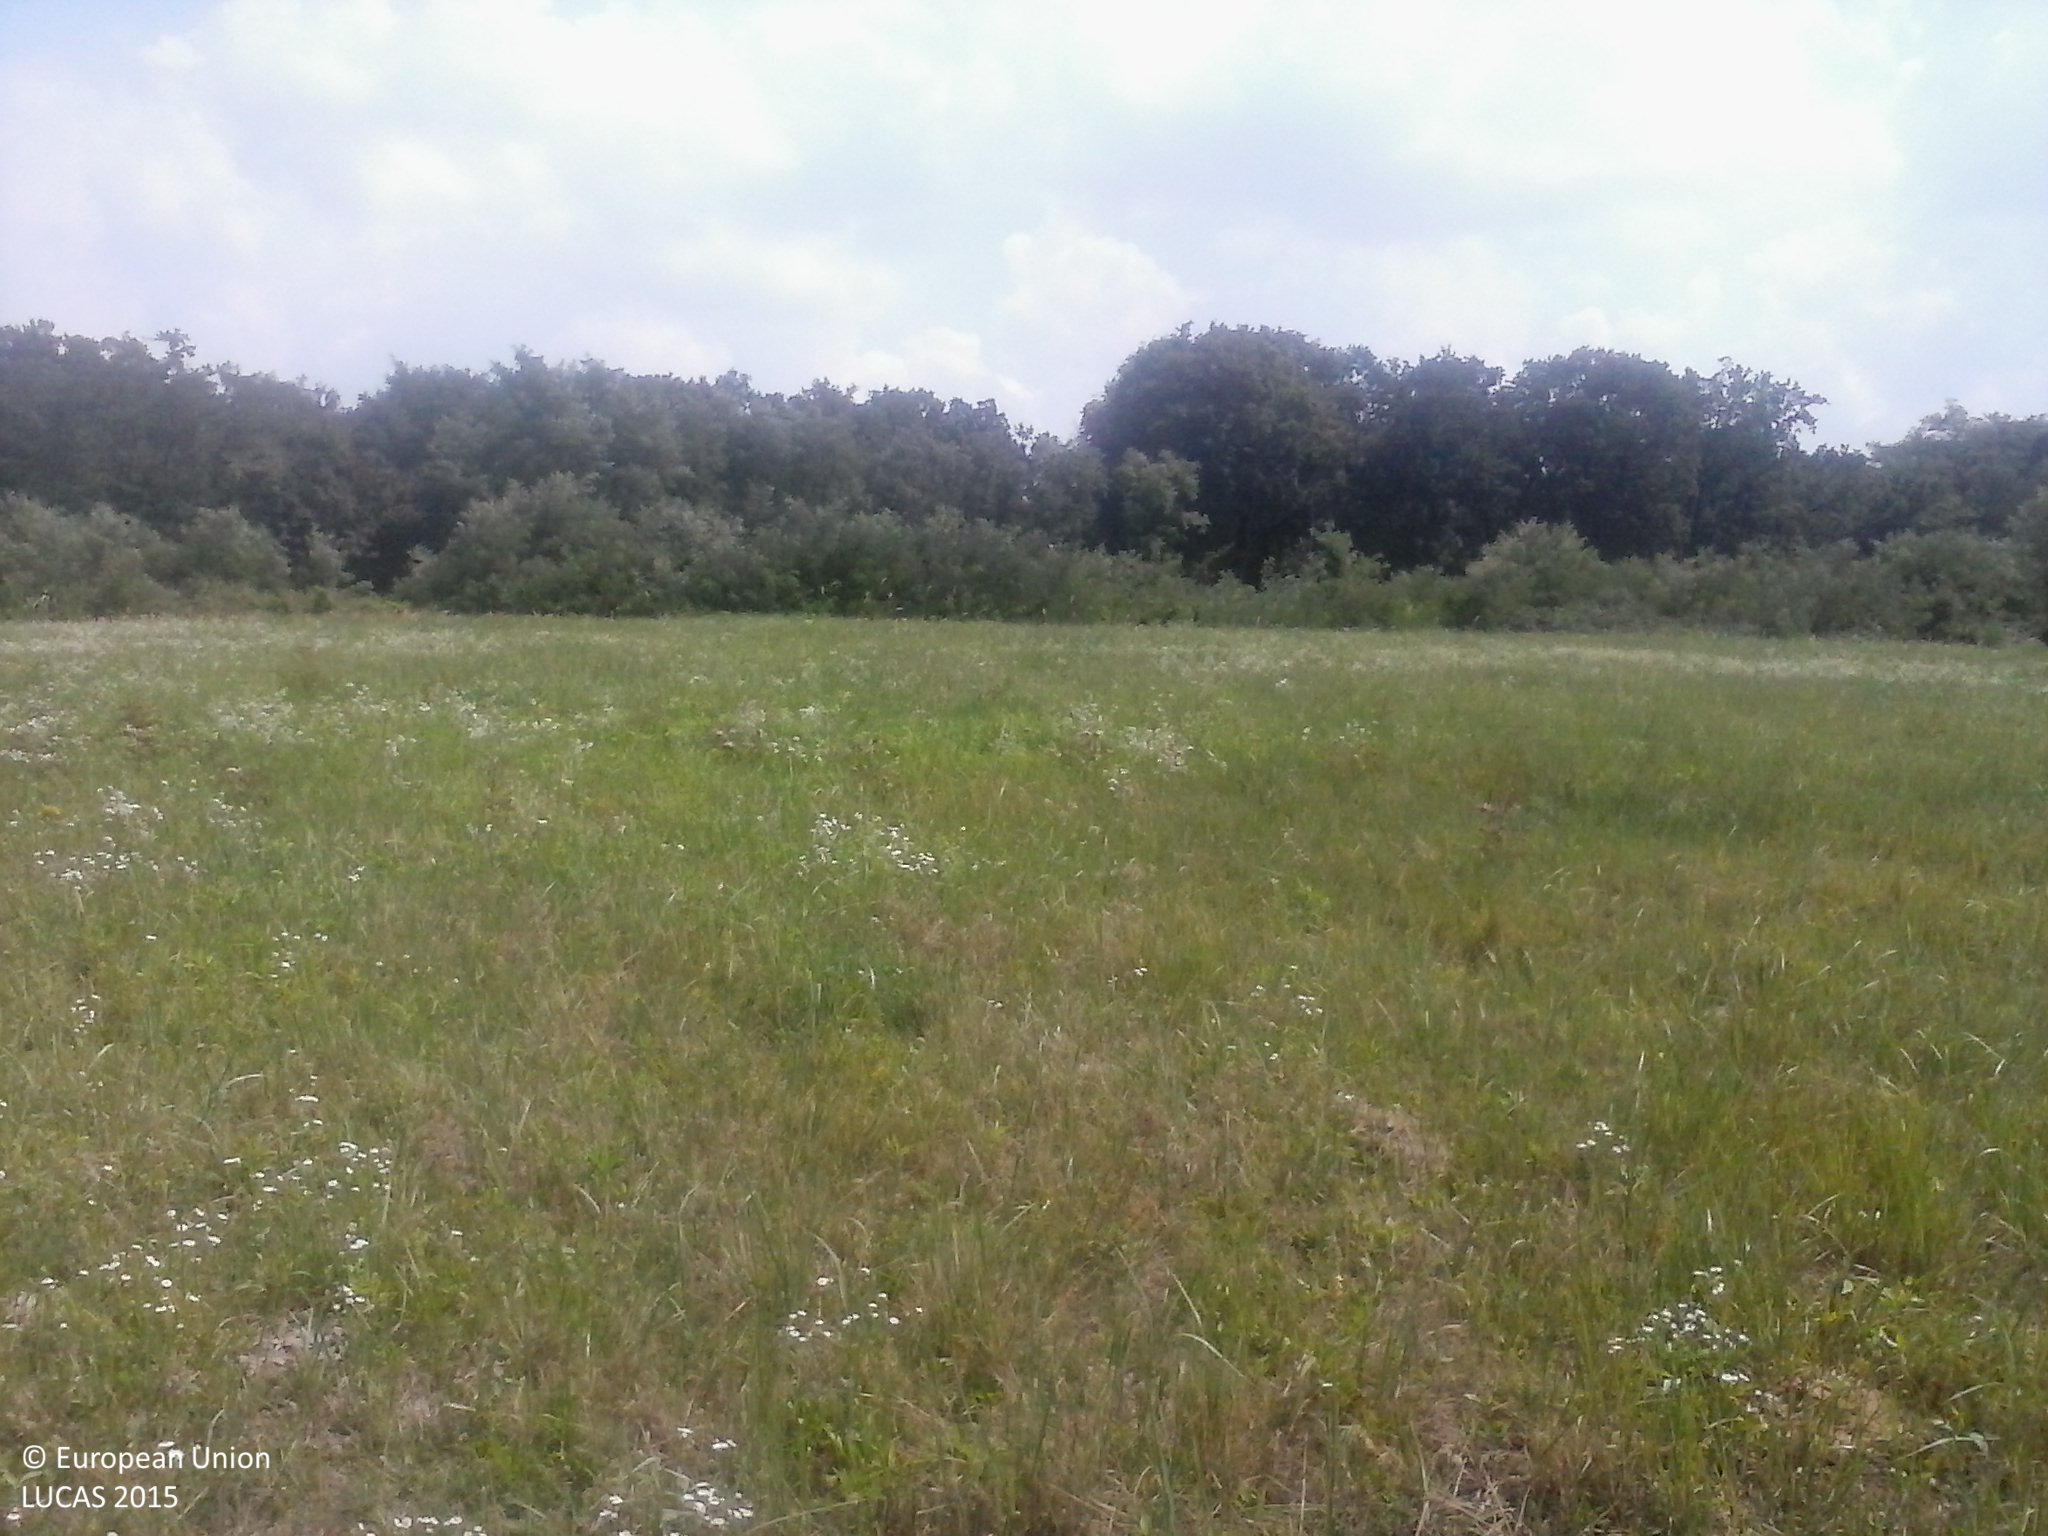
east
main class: Grassland
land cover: Grassland without tree/shrub cover
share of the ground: > 75 %
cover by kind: herbaceous plants 100 %
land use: Agriculture (excluding fallow land and kitchen gardens)
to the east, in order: Grassland without tree/shrub cover; Fences; Grass margins; Tracks; Grassland without tree/shrub cover; Tracks; Broadleaved woodland
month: August
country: HU
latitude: 46.1339
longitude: 17.8622
